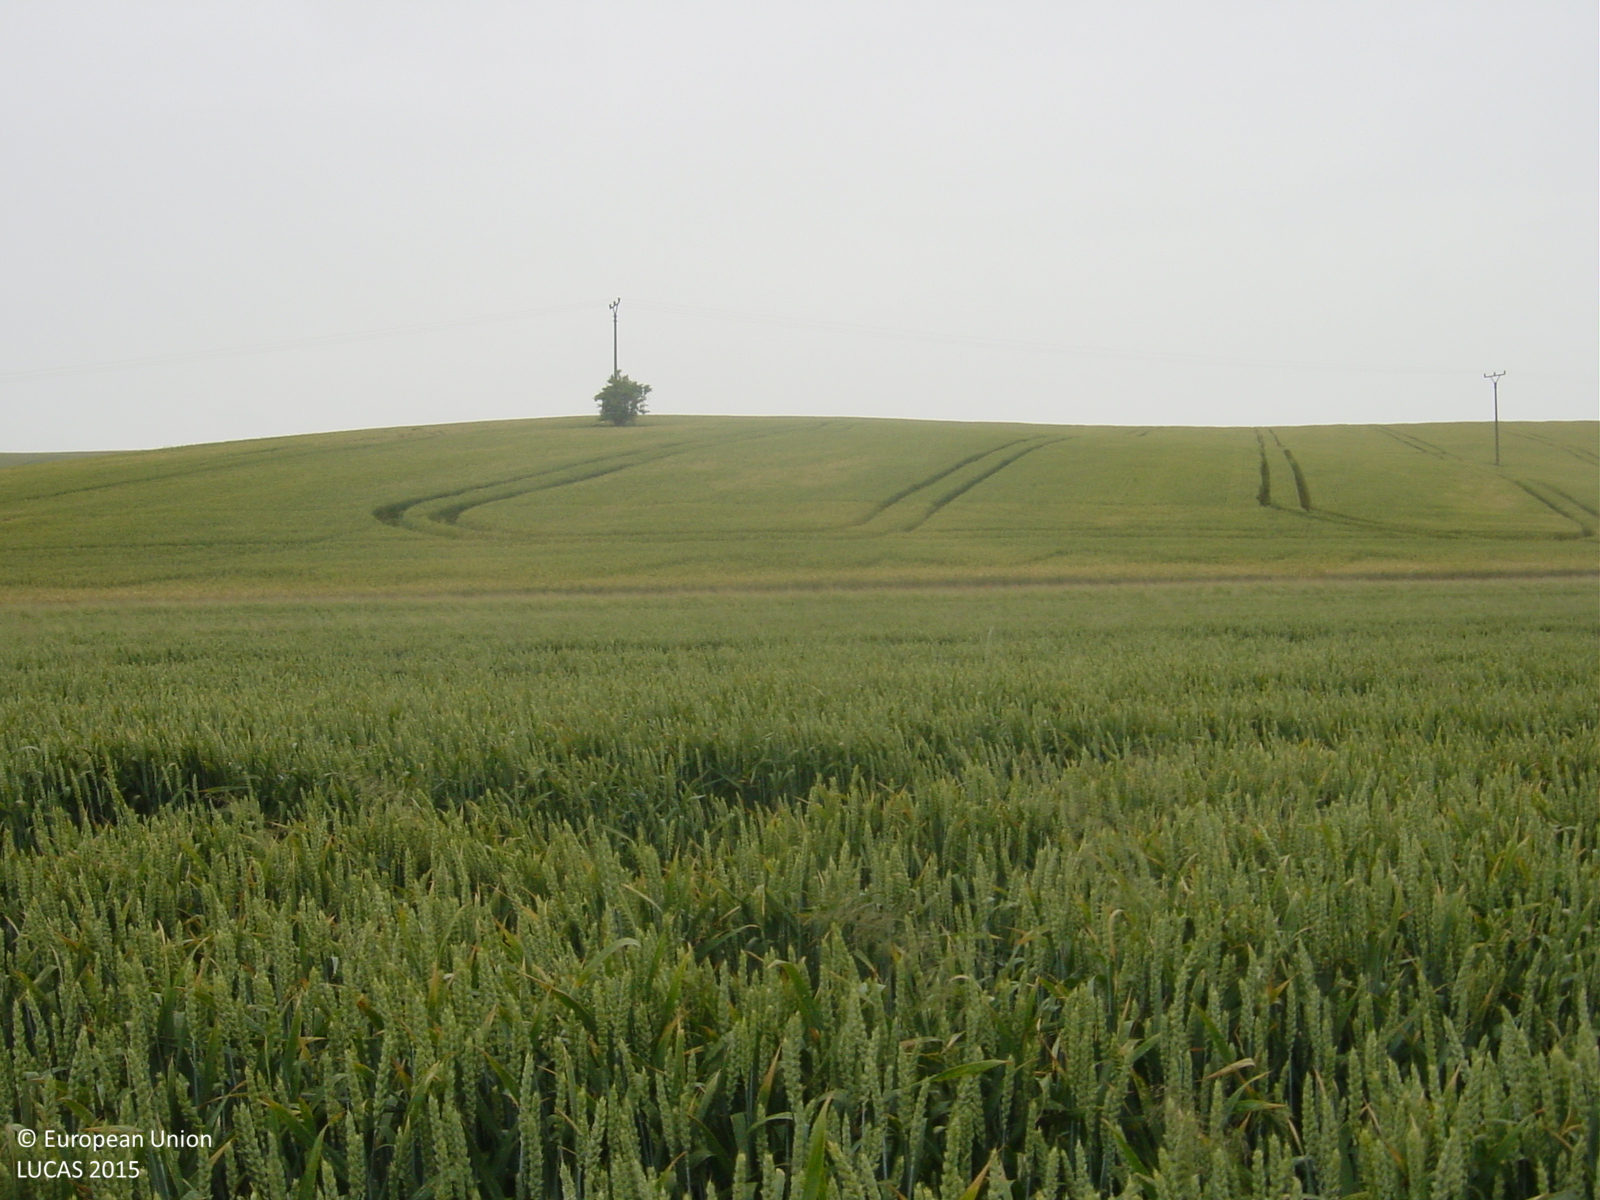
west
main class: Cropland
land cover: Common wheat
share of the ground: > 75 %
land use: Agriculture (excluding fallow land and kitchen gardens)
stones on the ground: < 10 %
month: June
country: CZ
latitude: 48.9392
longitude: 17.0125
